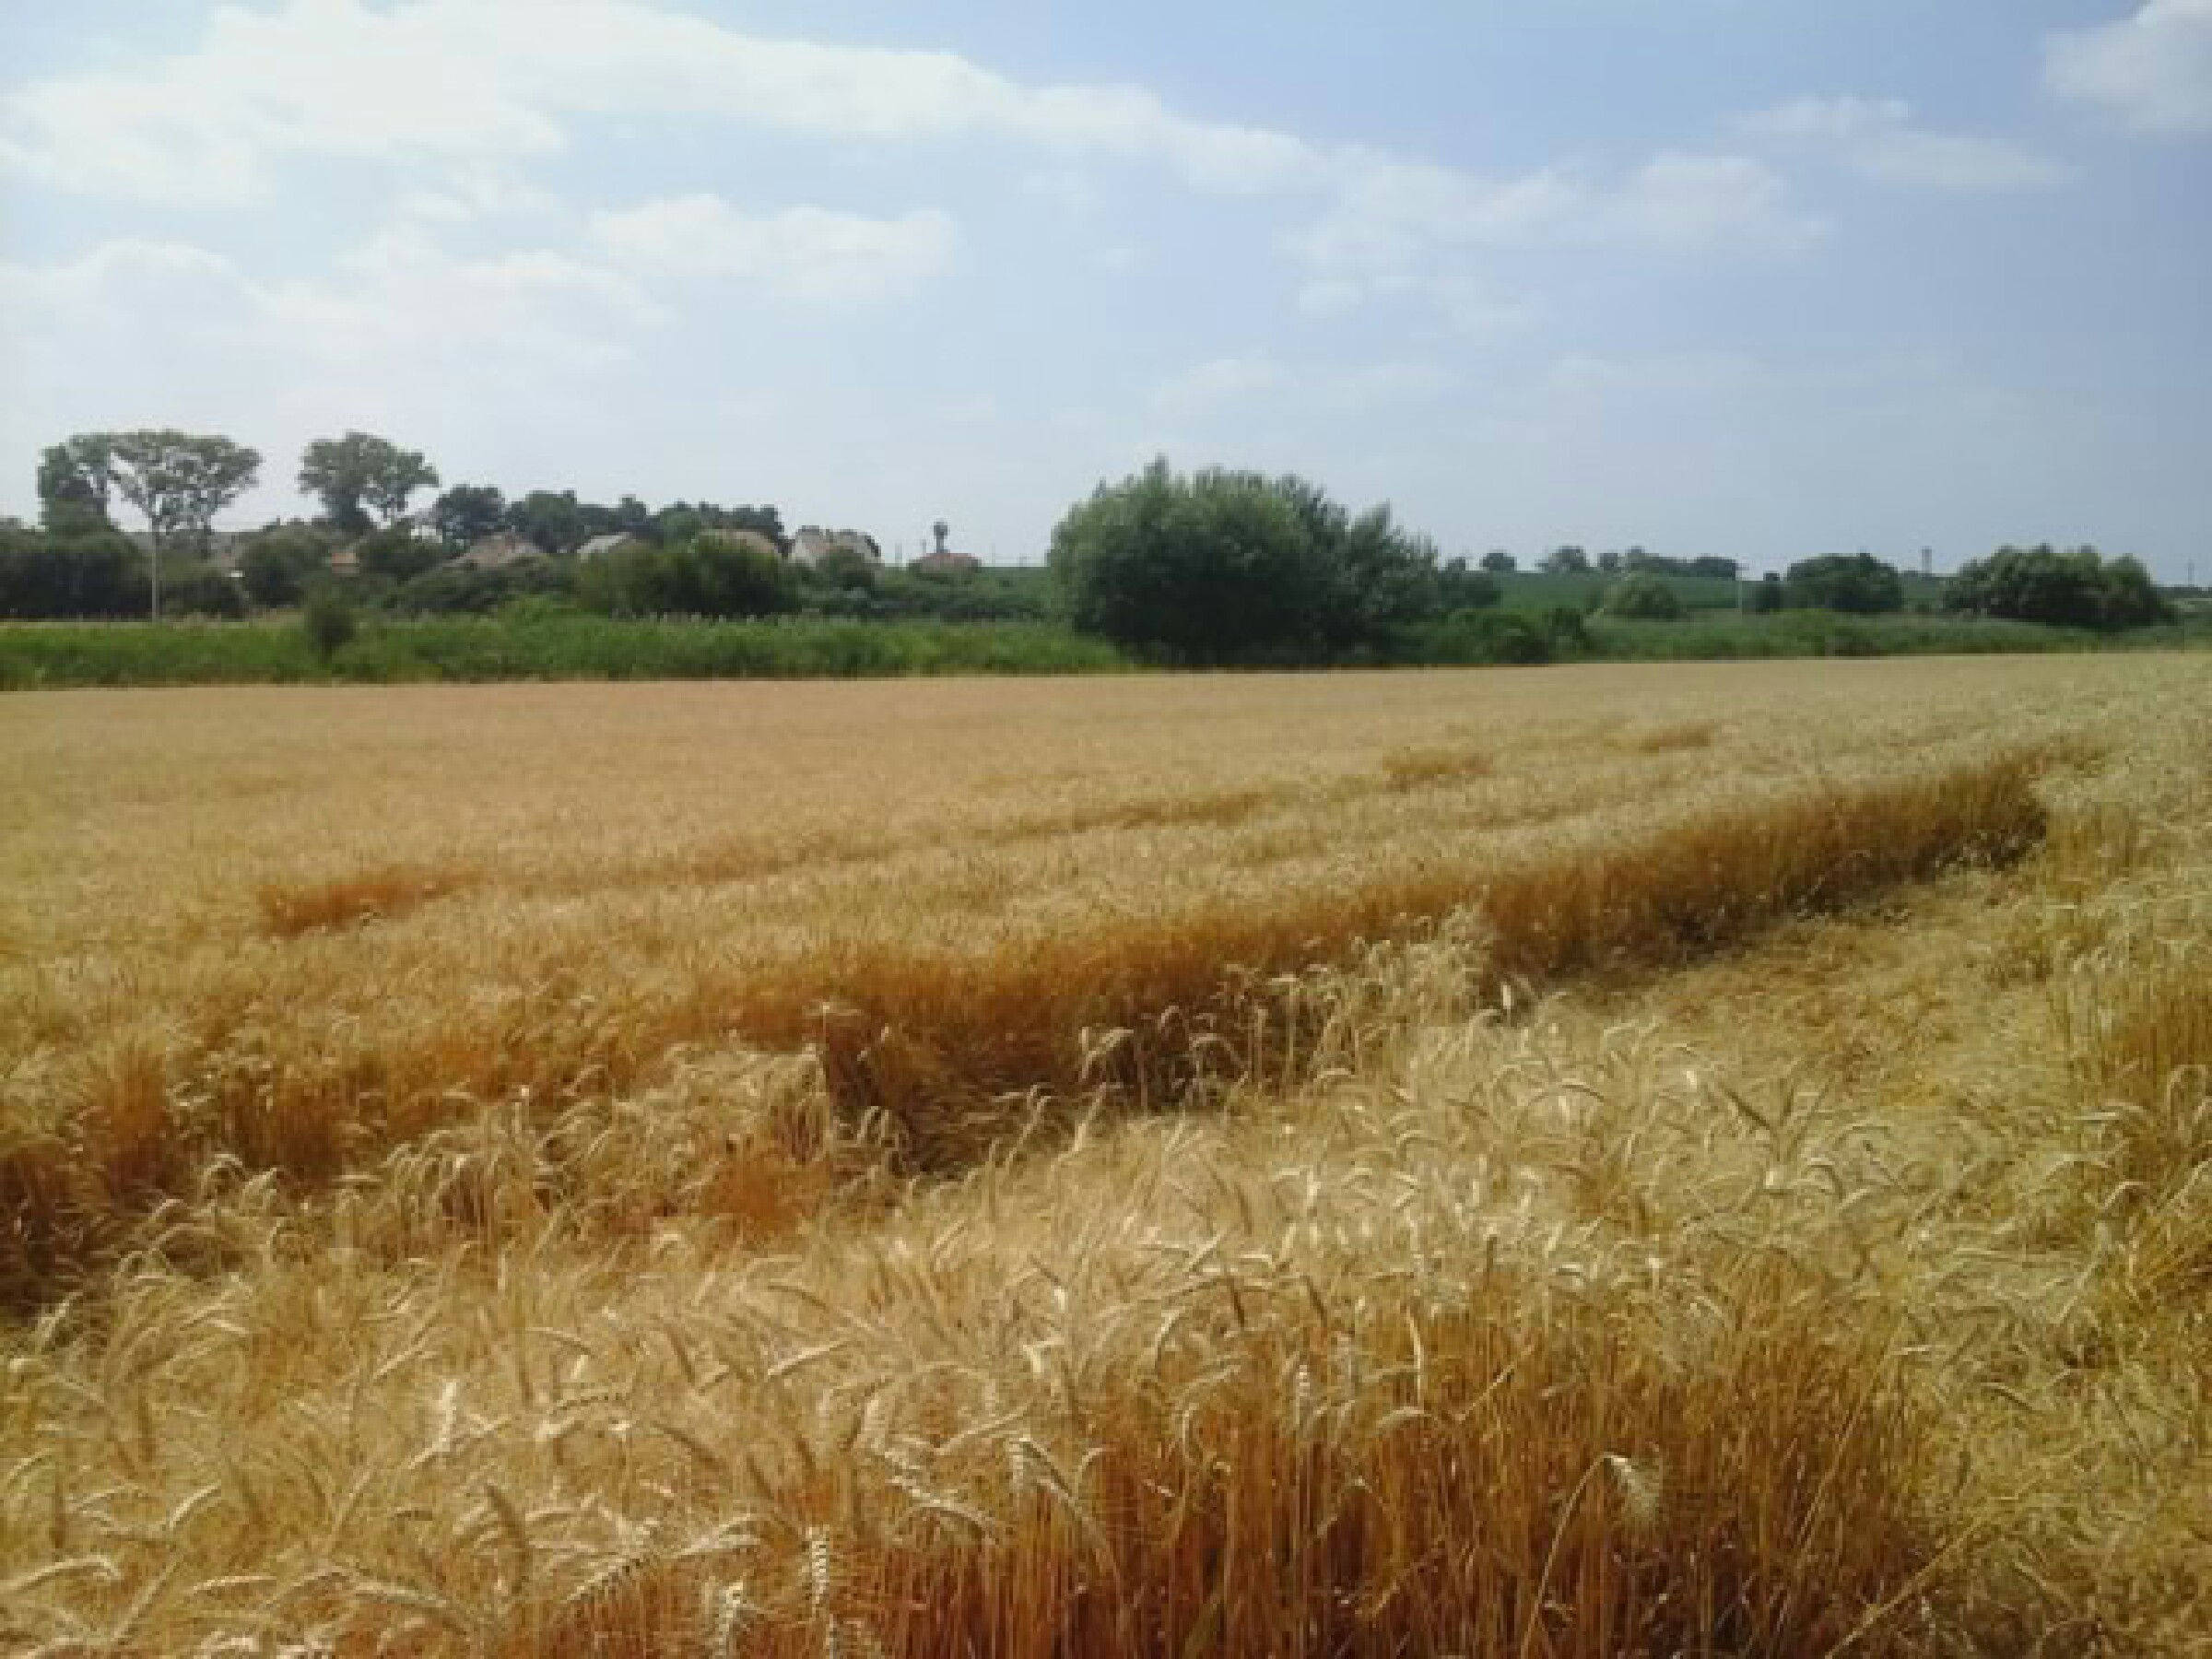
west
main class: Cropland
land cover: Common wheat
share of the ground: > 75 %
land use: Agriculture (excluding fallow land and kitchen gardens)
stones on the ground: < 10 %
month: July
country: HU
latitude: 47.8581
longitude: 19.3915
